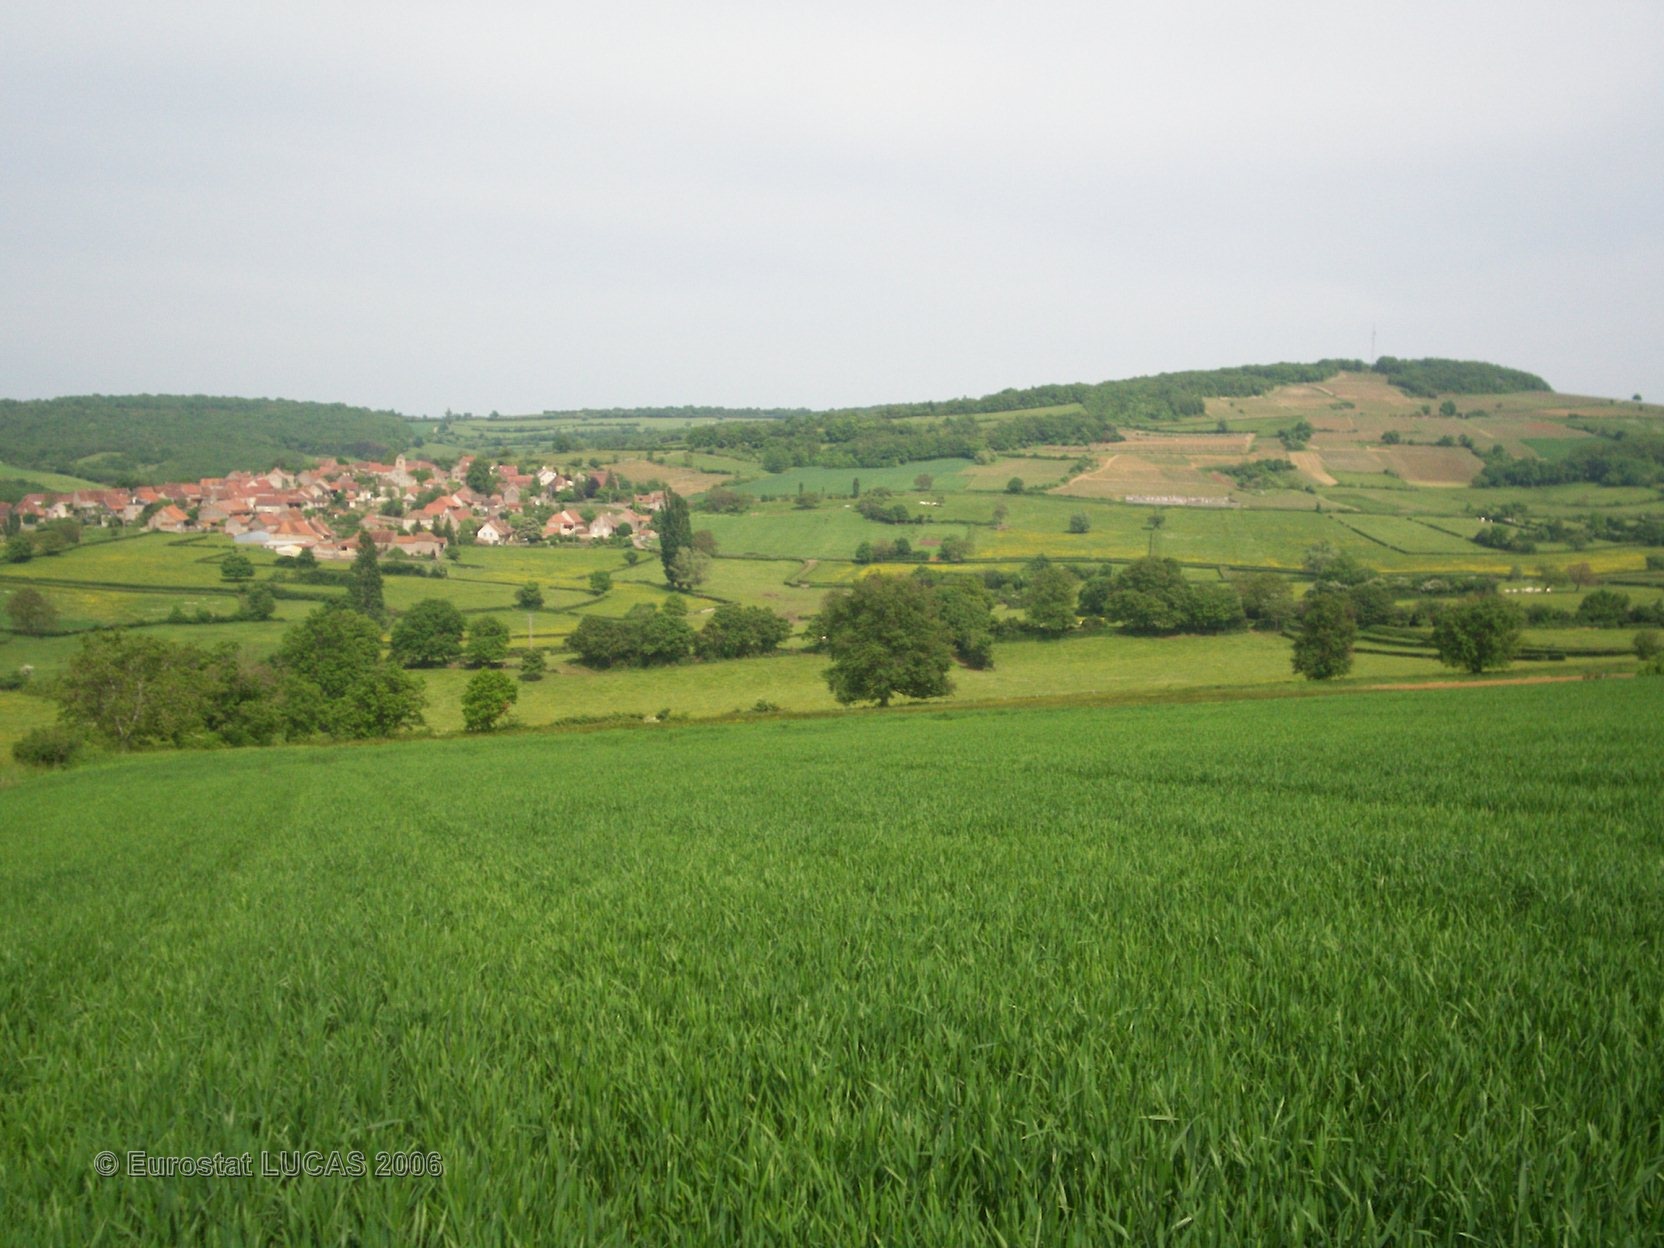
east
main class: Cropland
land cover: Common wheat
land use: Agriculture (excluding fallow land and kitchen gardens)
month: May
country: FR
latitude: 46.6675
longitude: 4.6292
